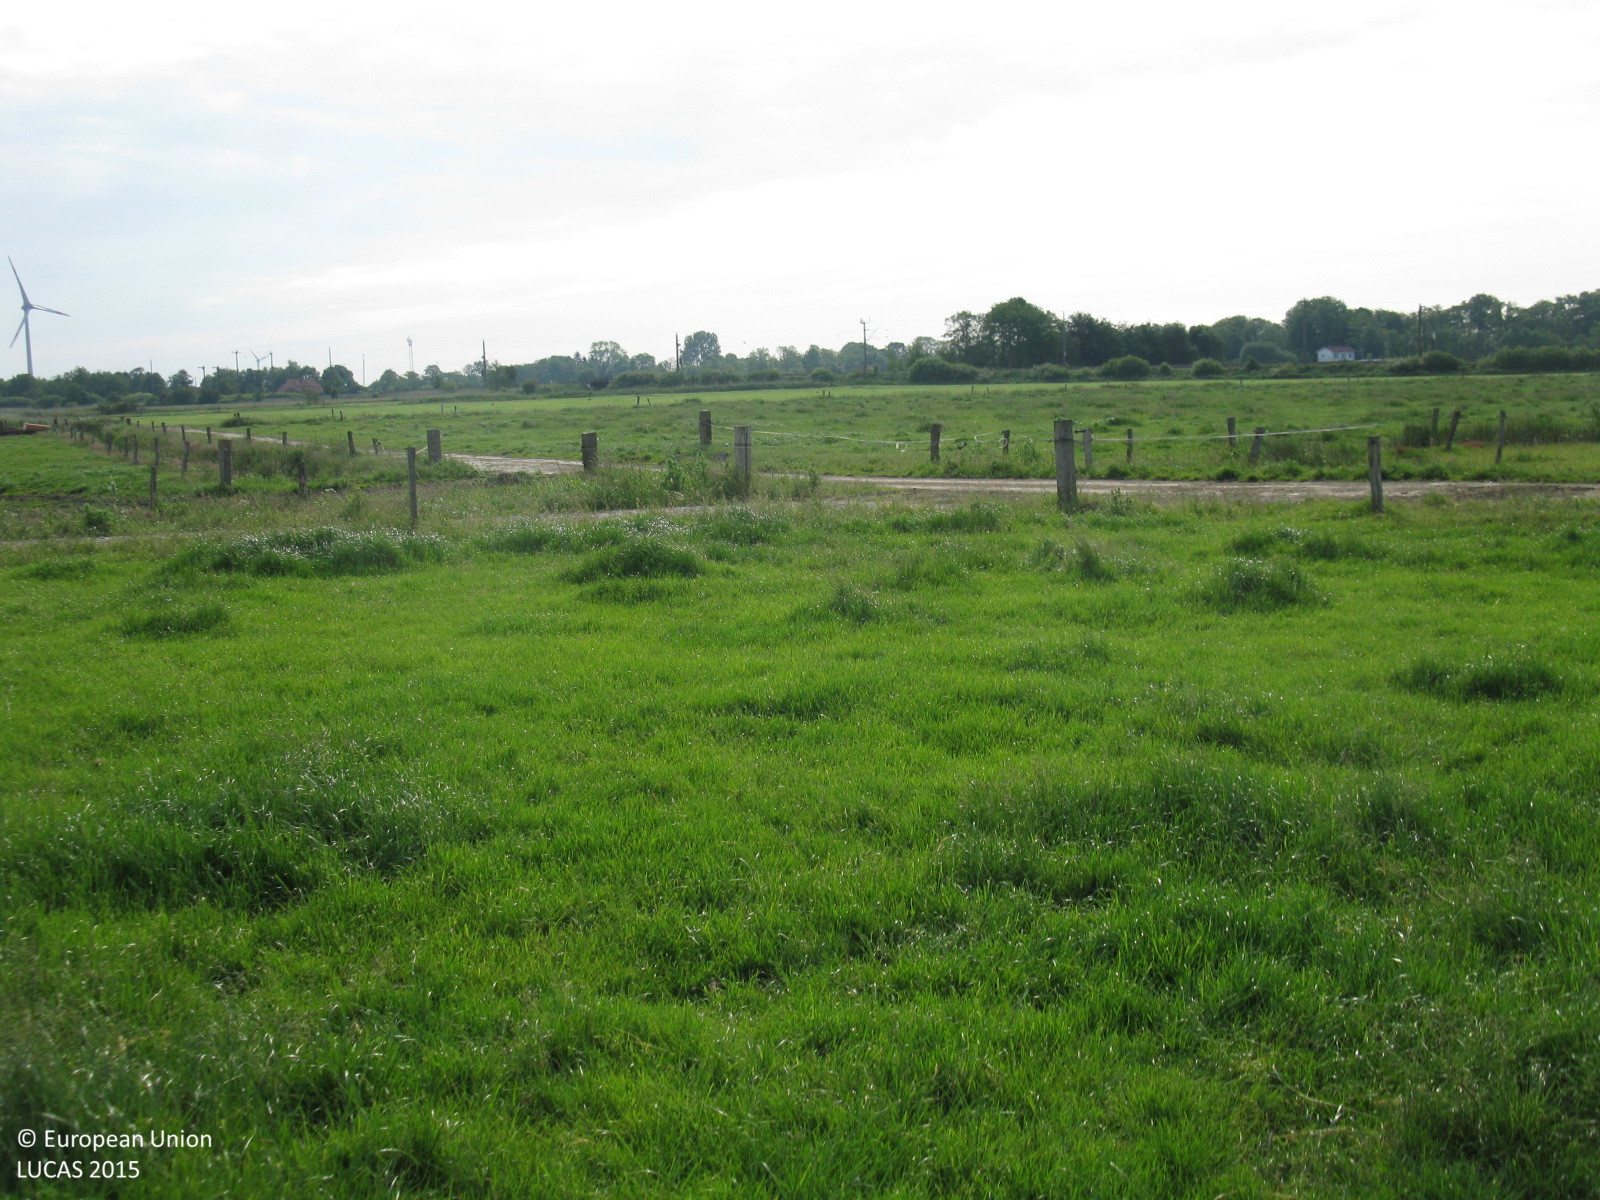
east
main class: Grassland
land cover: Grassland without tree/shrub cover
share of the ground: > 75 %
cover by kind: herbaceous plants 100 %
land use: Agriculture (excluding fallow land and kitchen gardens)
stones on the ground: < 10 %
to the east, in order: Grassland without tree/shrub cover; Fences; Tracks; Fences; Grass margins; Ditches and canals; Grass margins; Fences; Grassland without tree/shrub cover; Paved roads, cycling and walking lanes; Grassland without tree/shrub cover; Fences; Grass margins; Ditches and canals; Grass margins; Fences; Grassland without tree/shrub cover
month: June
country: DE
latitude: 53.4612
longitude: 7.2745
